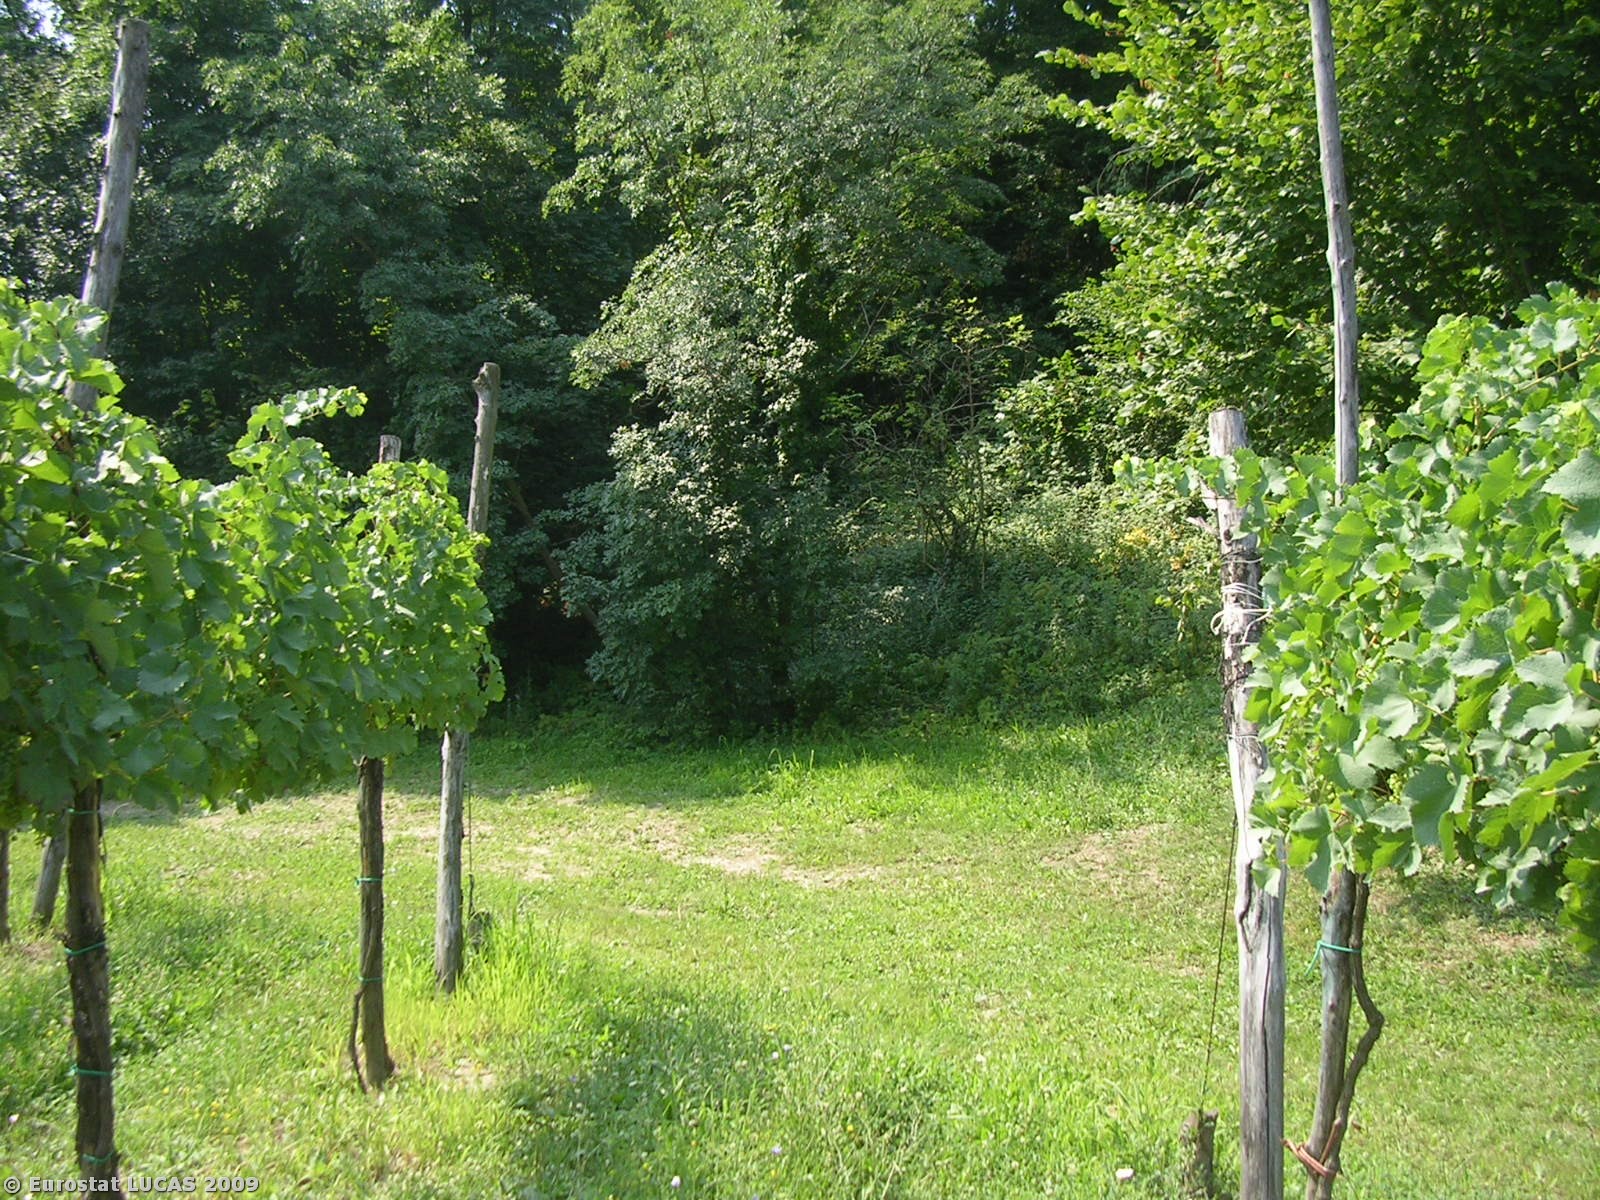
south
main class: Cropland
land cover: Vineyards
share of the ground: > 75 %
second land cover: Grassland with sparse tree/shrub cover
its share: 10 - 25 %
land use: Agriculture (excluding fallow land and kitchen gardens)
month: July
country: IT
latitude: 45.3462
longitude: 11.7201
